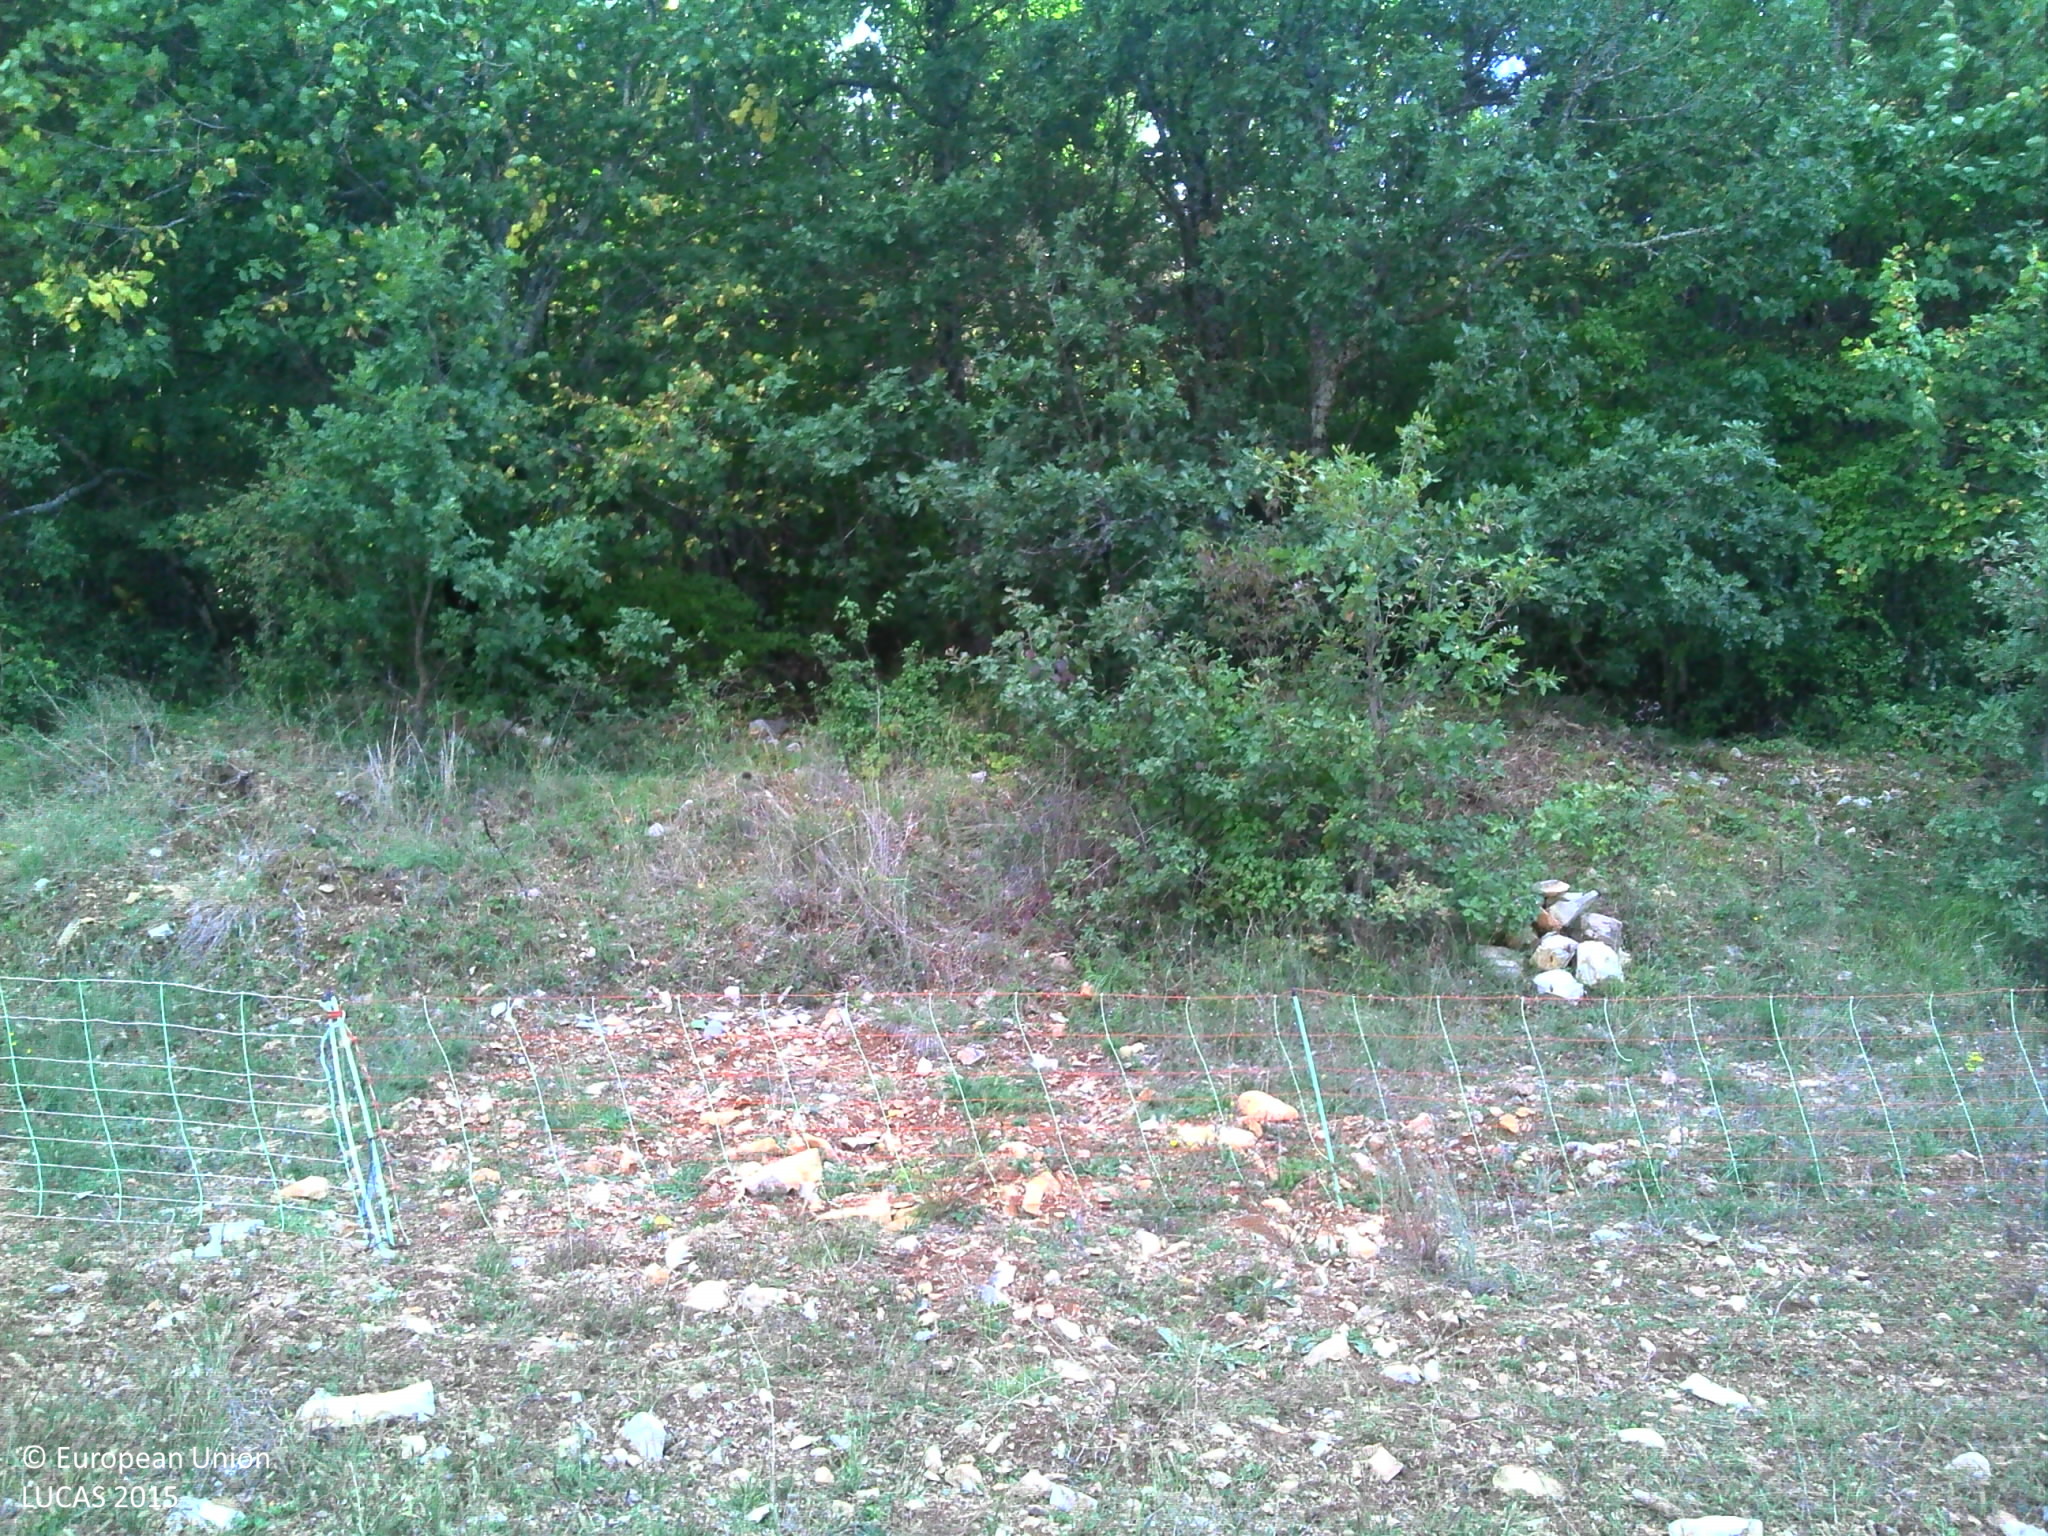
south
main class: Grassland
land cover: Grassland without tree/shrub cover
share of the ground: 50 - 75 %
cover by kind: herbaceous plants 60 %, unconsolidated bare surface 40 %
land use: Agriculture (excluding fallow land and kitchen gardens)
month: September
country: FR
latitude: 44.2862
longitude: 5.4337
